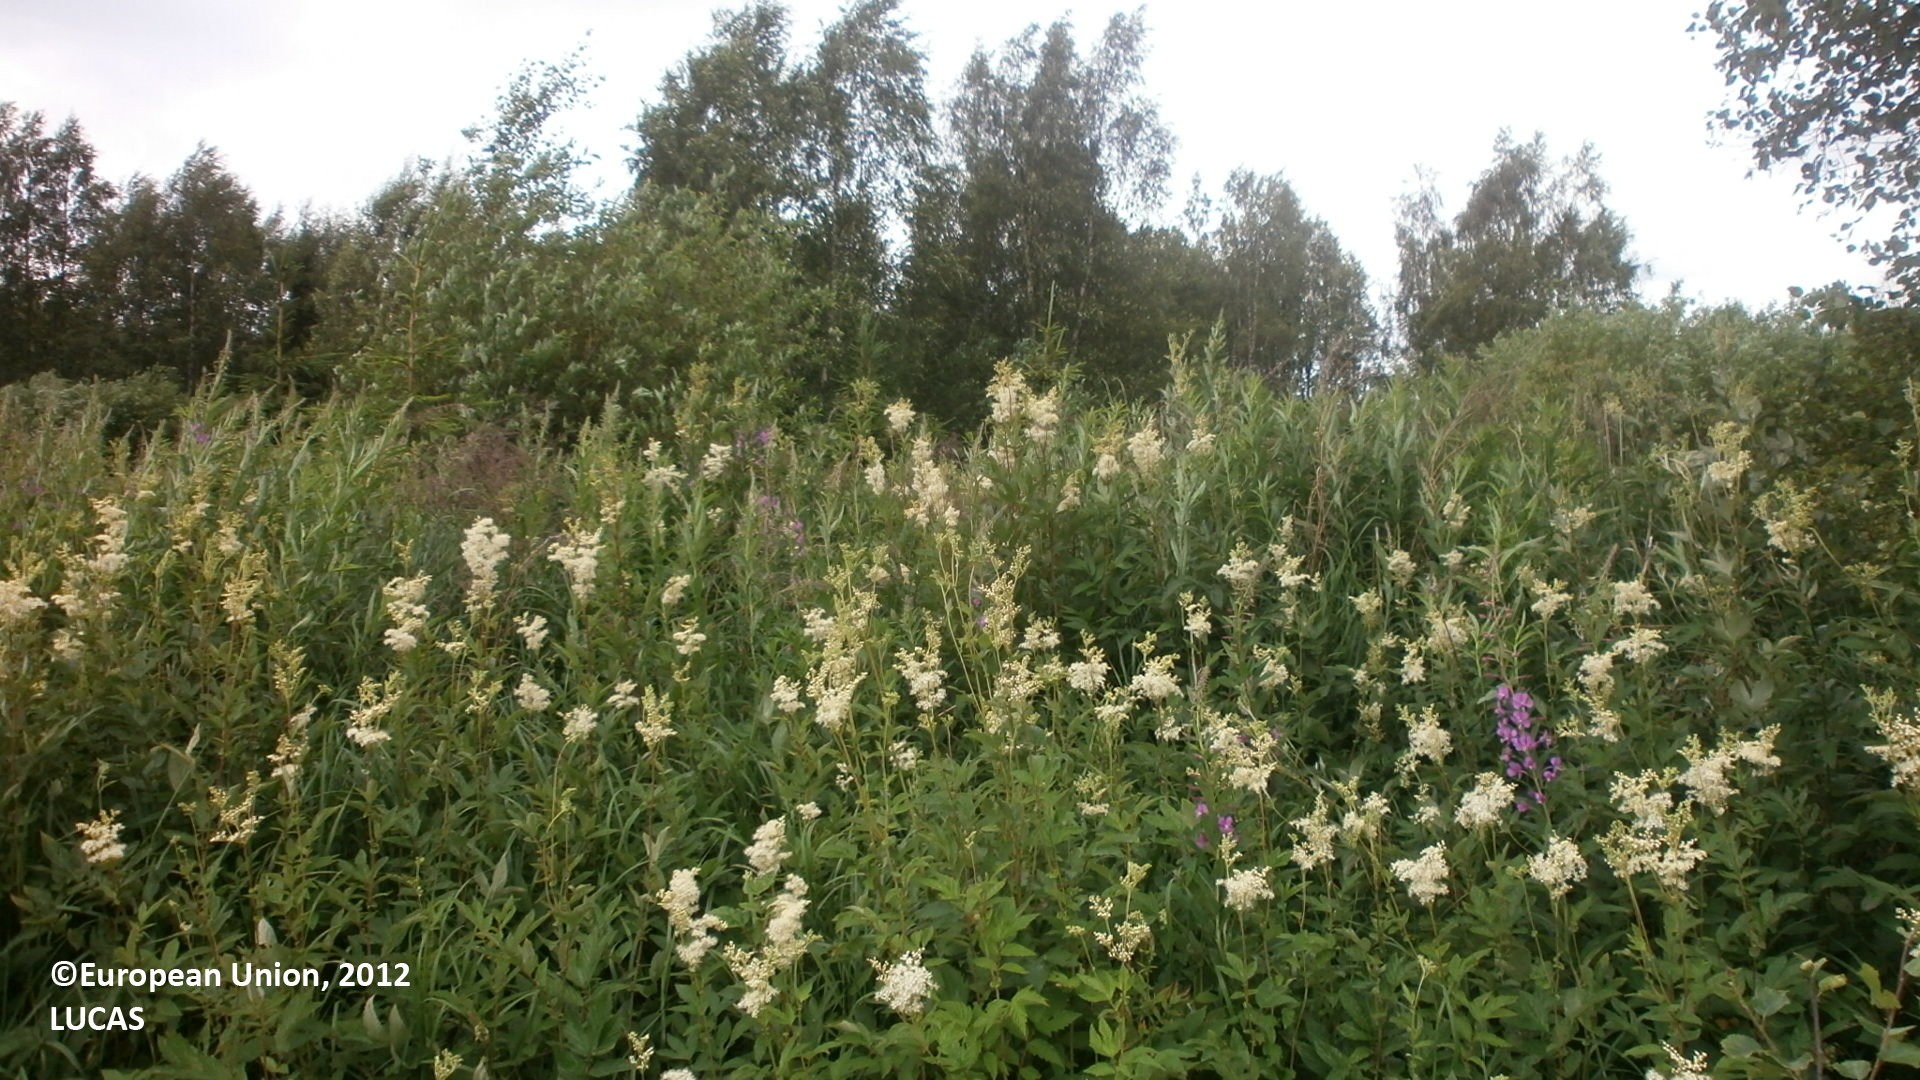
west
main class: Cropland
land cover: Oats
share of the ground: > 75 %
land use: Agriculture (excluding fallow land and kitchen gardens)
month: July
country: FI
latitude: 64.6212
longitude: 24.6029
